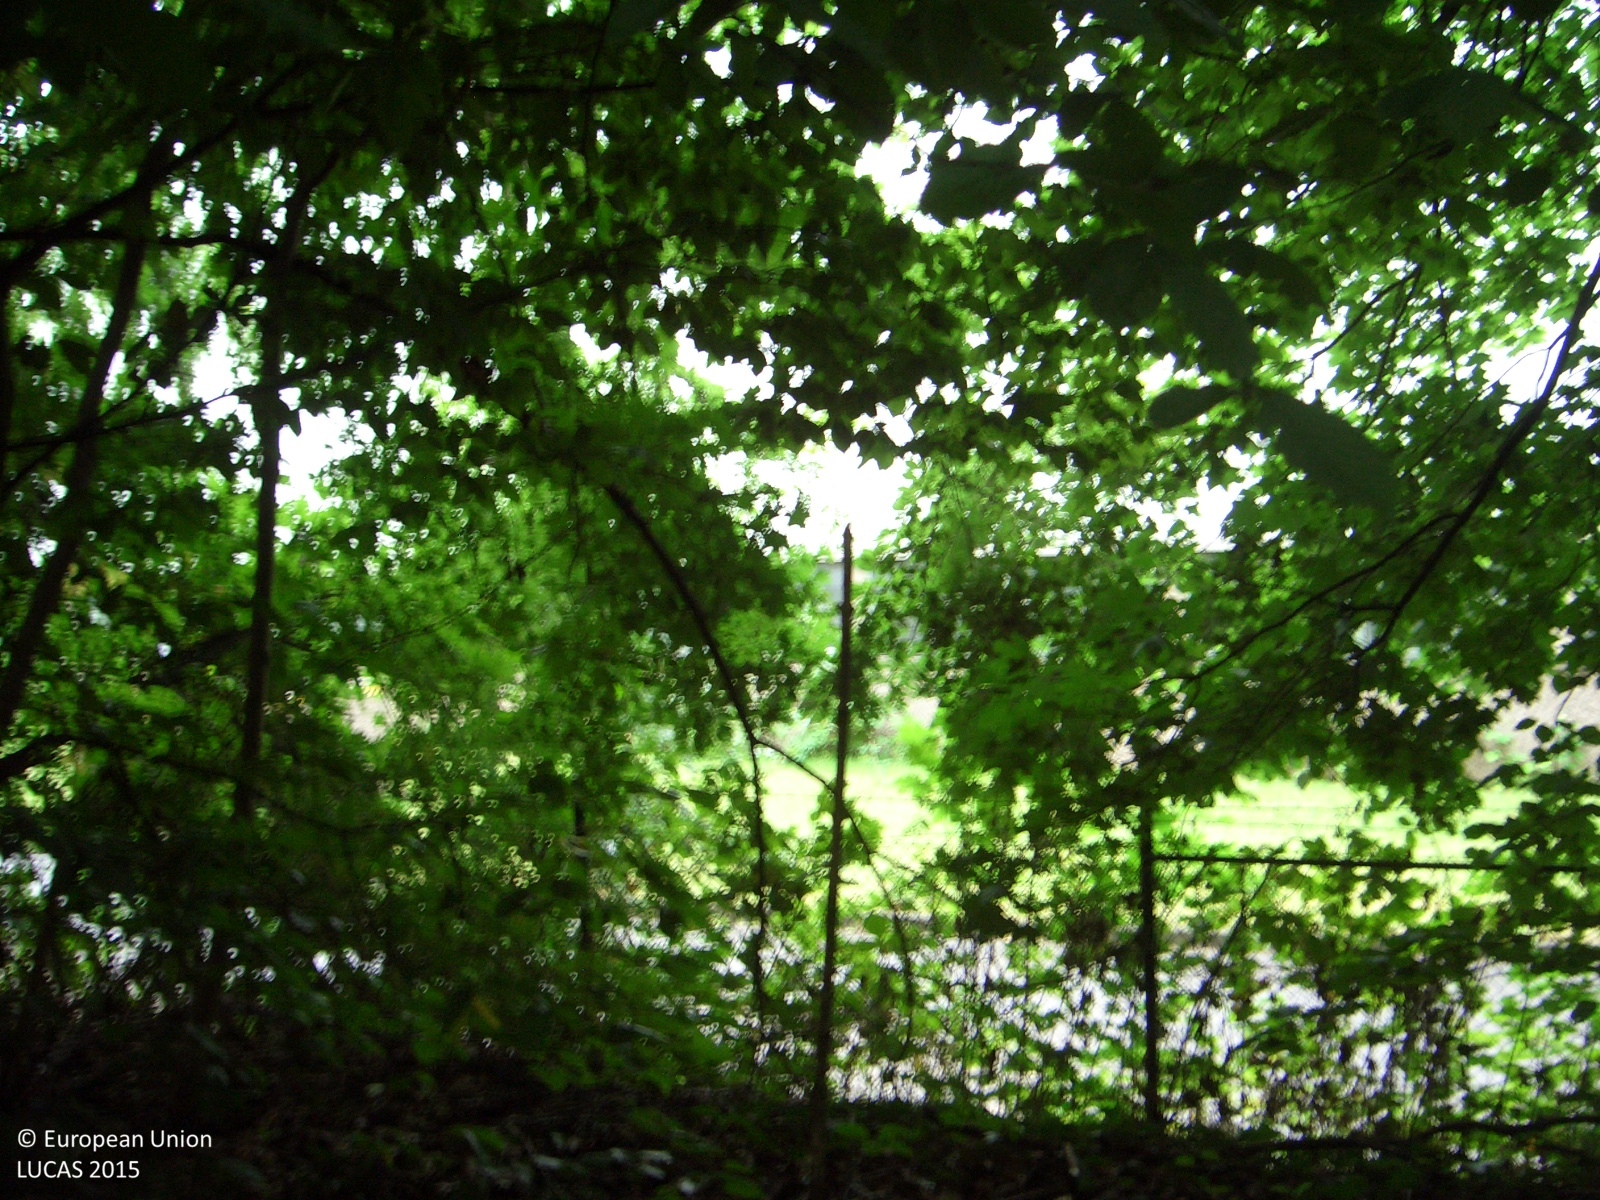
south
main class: Woodland
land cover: Broadleaved woodland
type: mesophytic deciduous forest
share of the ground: > 75 %
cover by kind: broadleaved forest trees 100 %
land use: Energy production
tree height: > 5 m
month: July
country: DE
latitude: 51.6024
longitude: 7.0114
